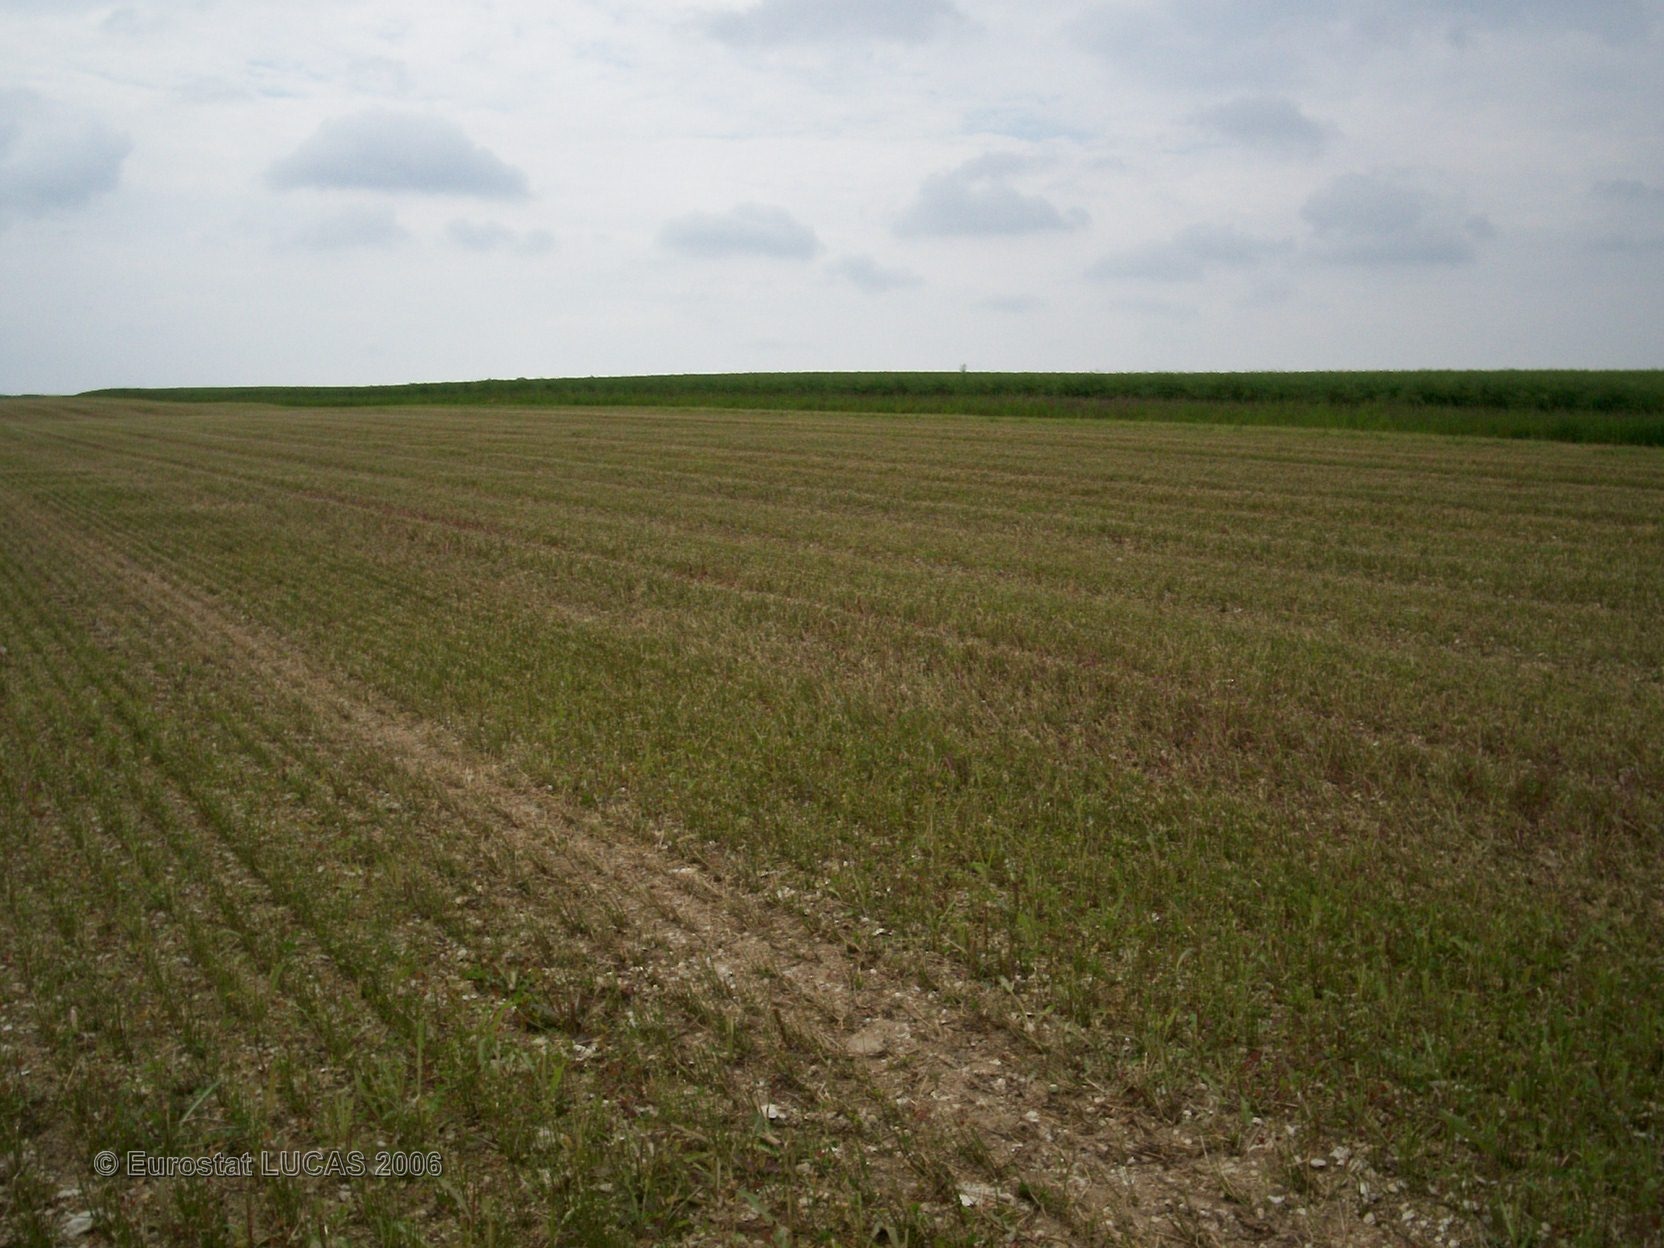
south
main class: Cropland
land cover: Lucerne
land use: Agriculture (excluding fallow land and kitchen gardens)
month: June
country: FR
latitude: 48.6812
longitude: 4.4962
